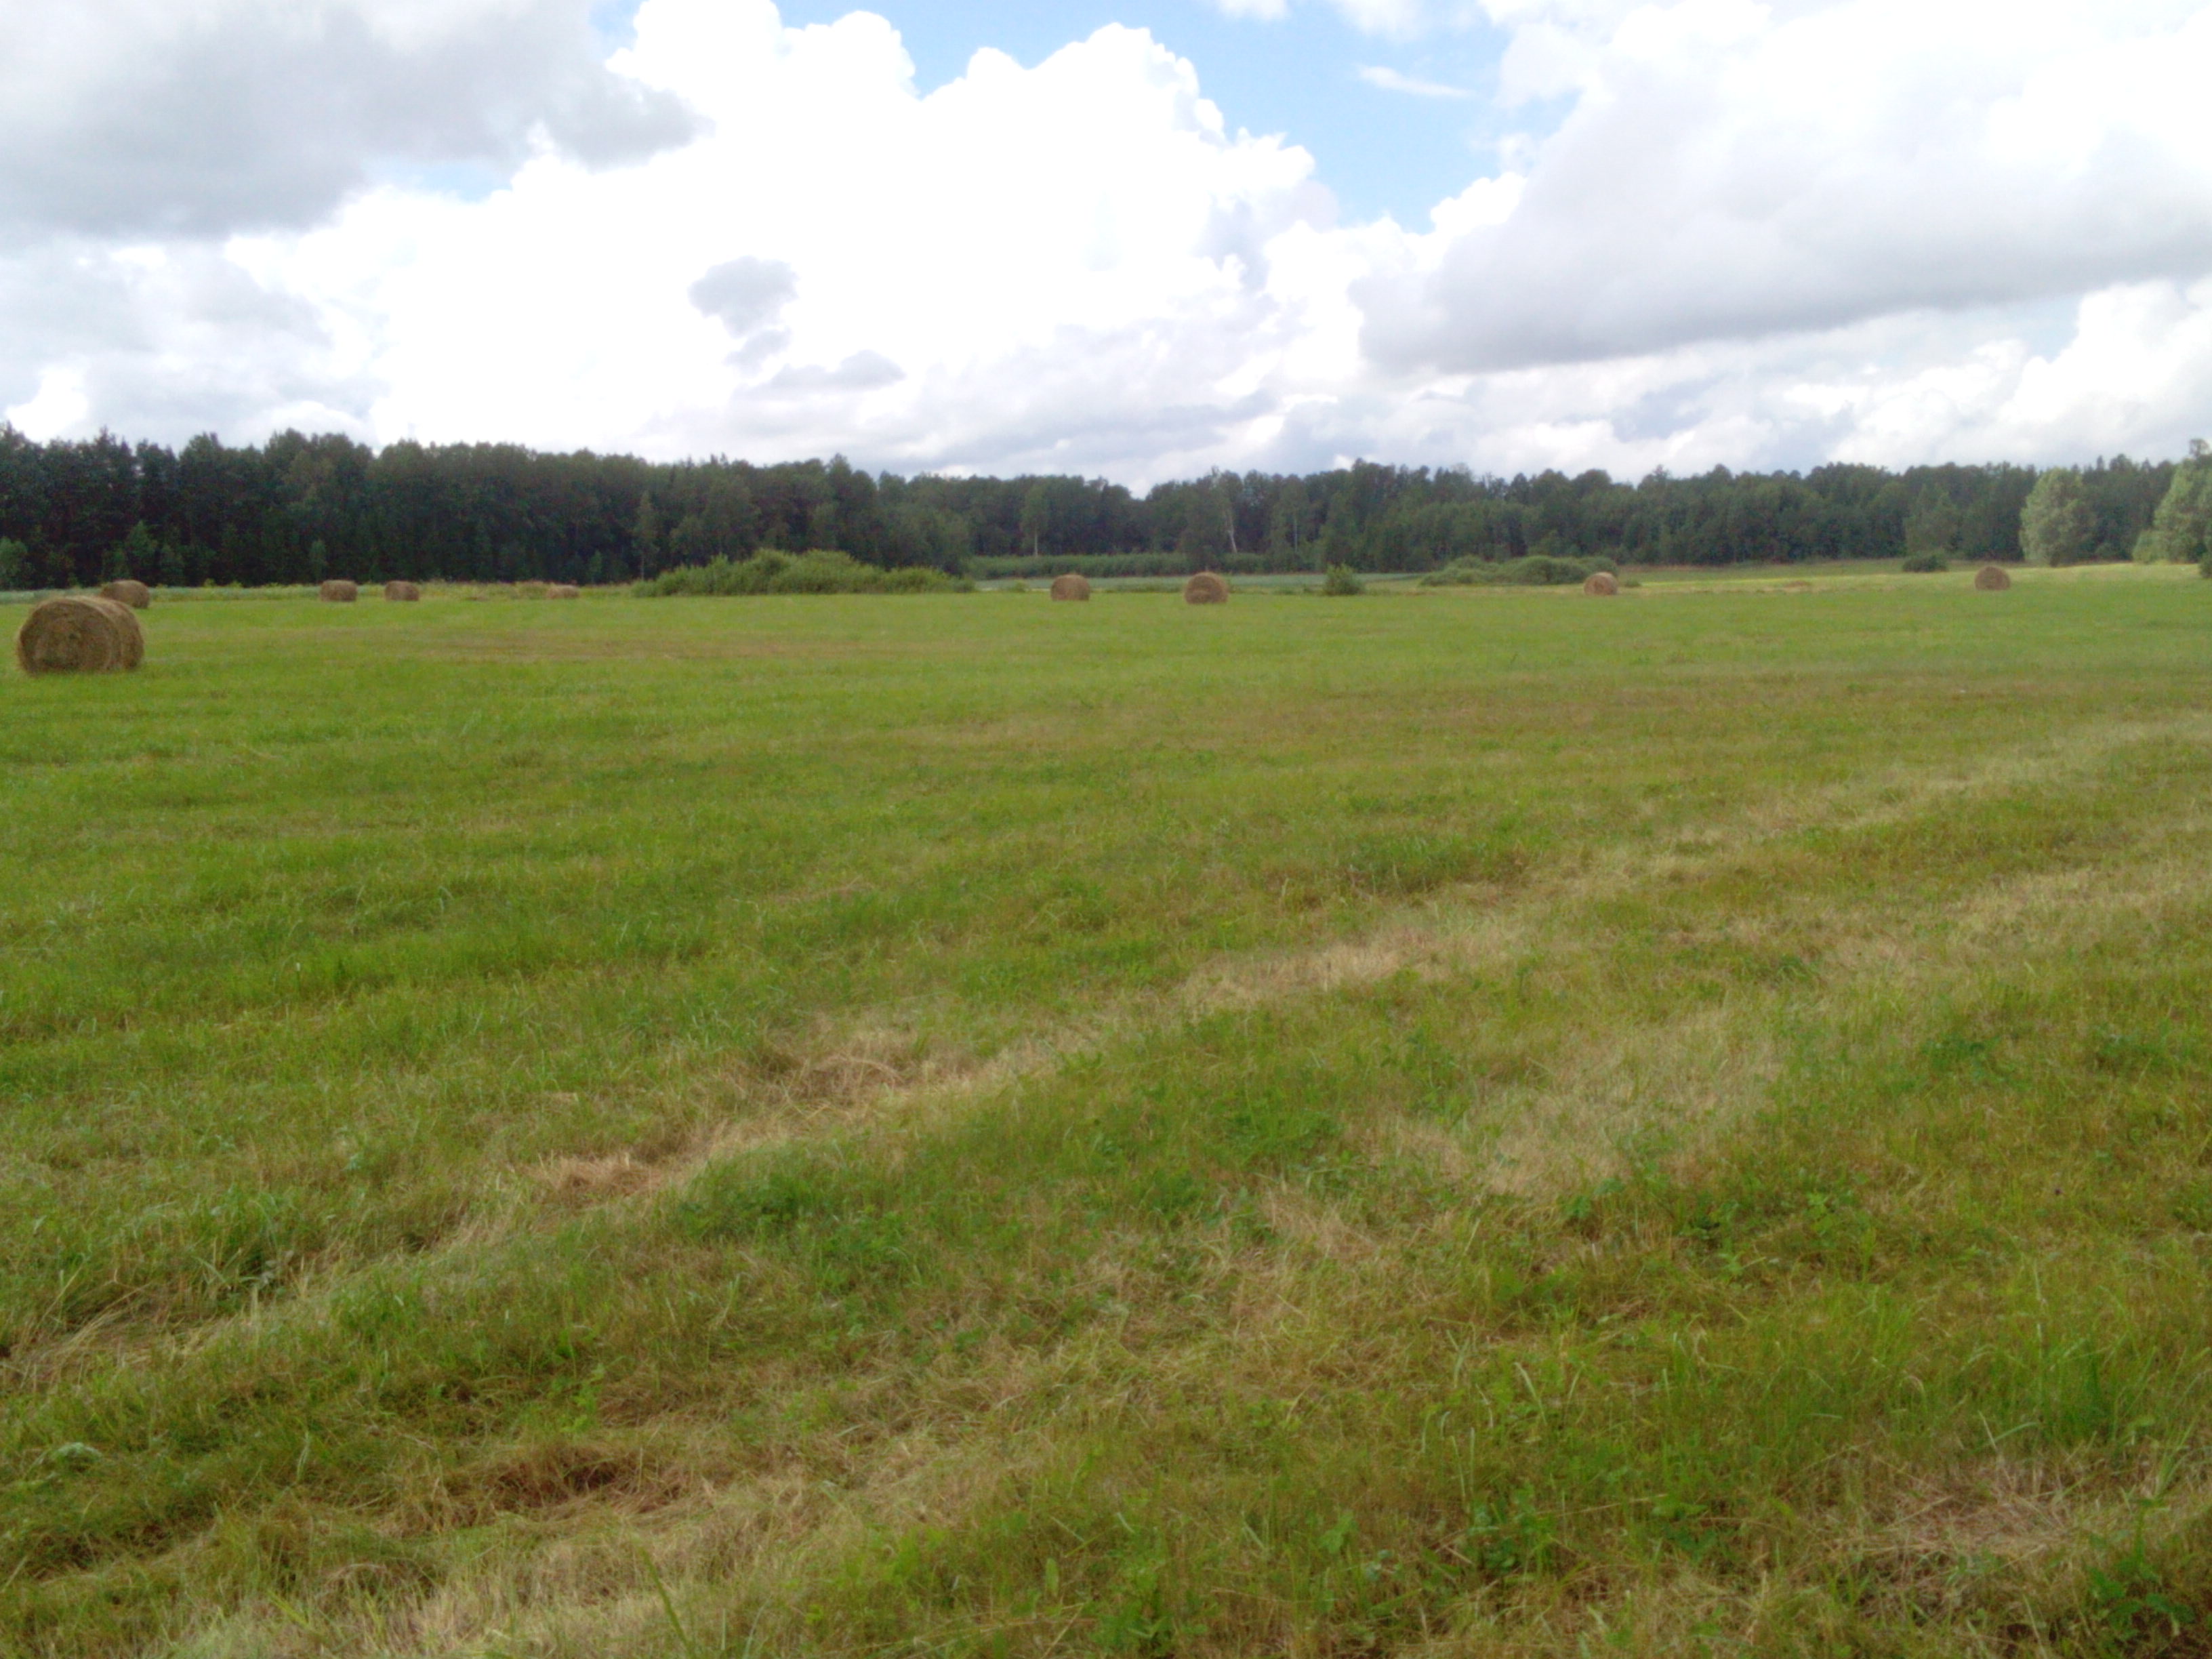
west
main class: Grassland
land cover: Grassland without tree/shrub cover
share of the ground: > 75 %
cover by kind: herbaceous plants 100 %
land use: Agriculture (excluding fallow land and kitchen gardens)
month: July
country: LV
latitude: 56.9657
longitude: 22.0383
